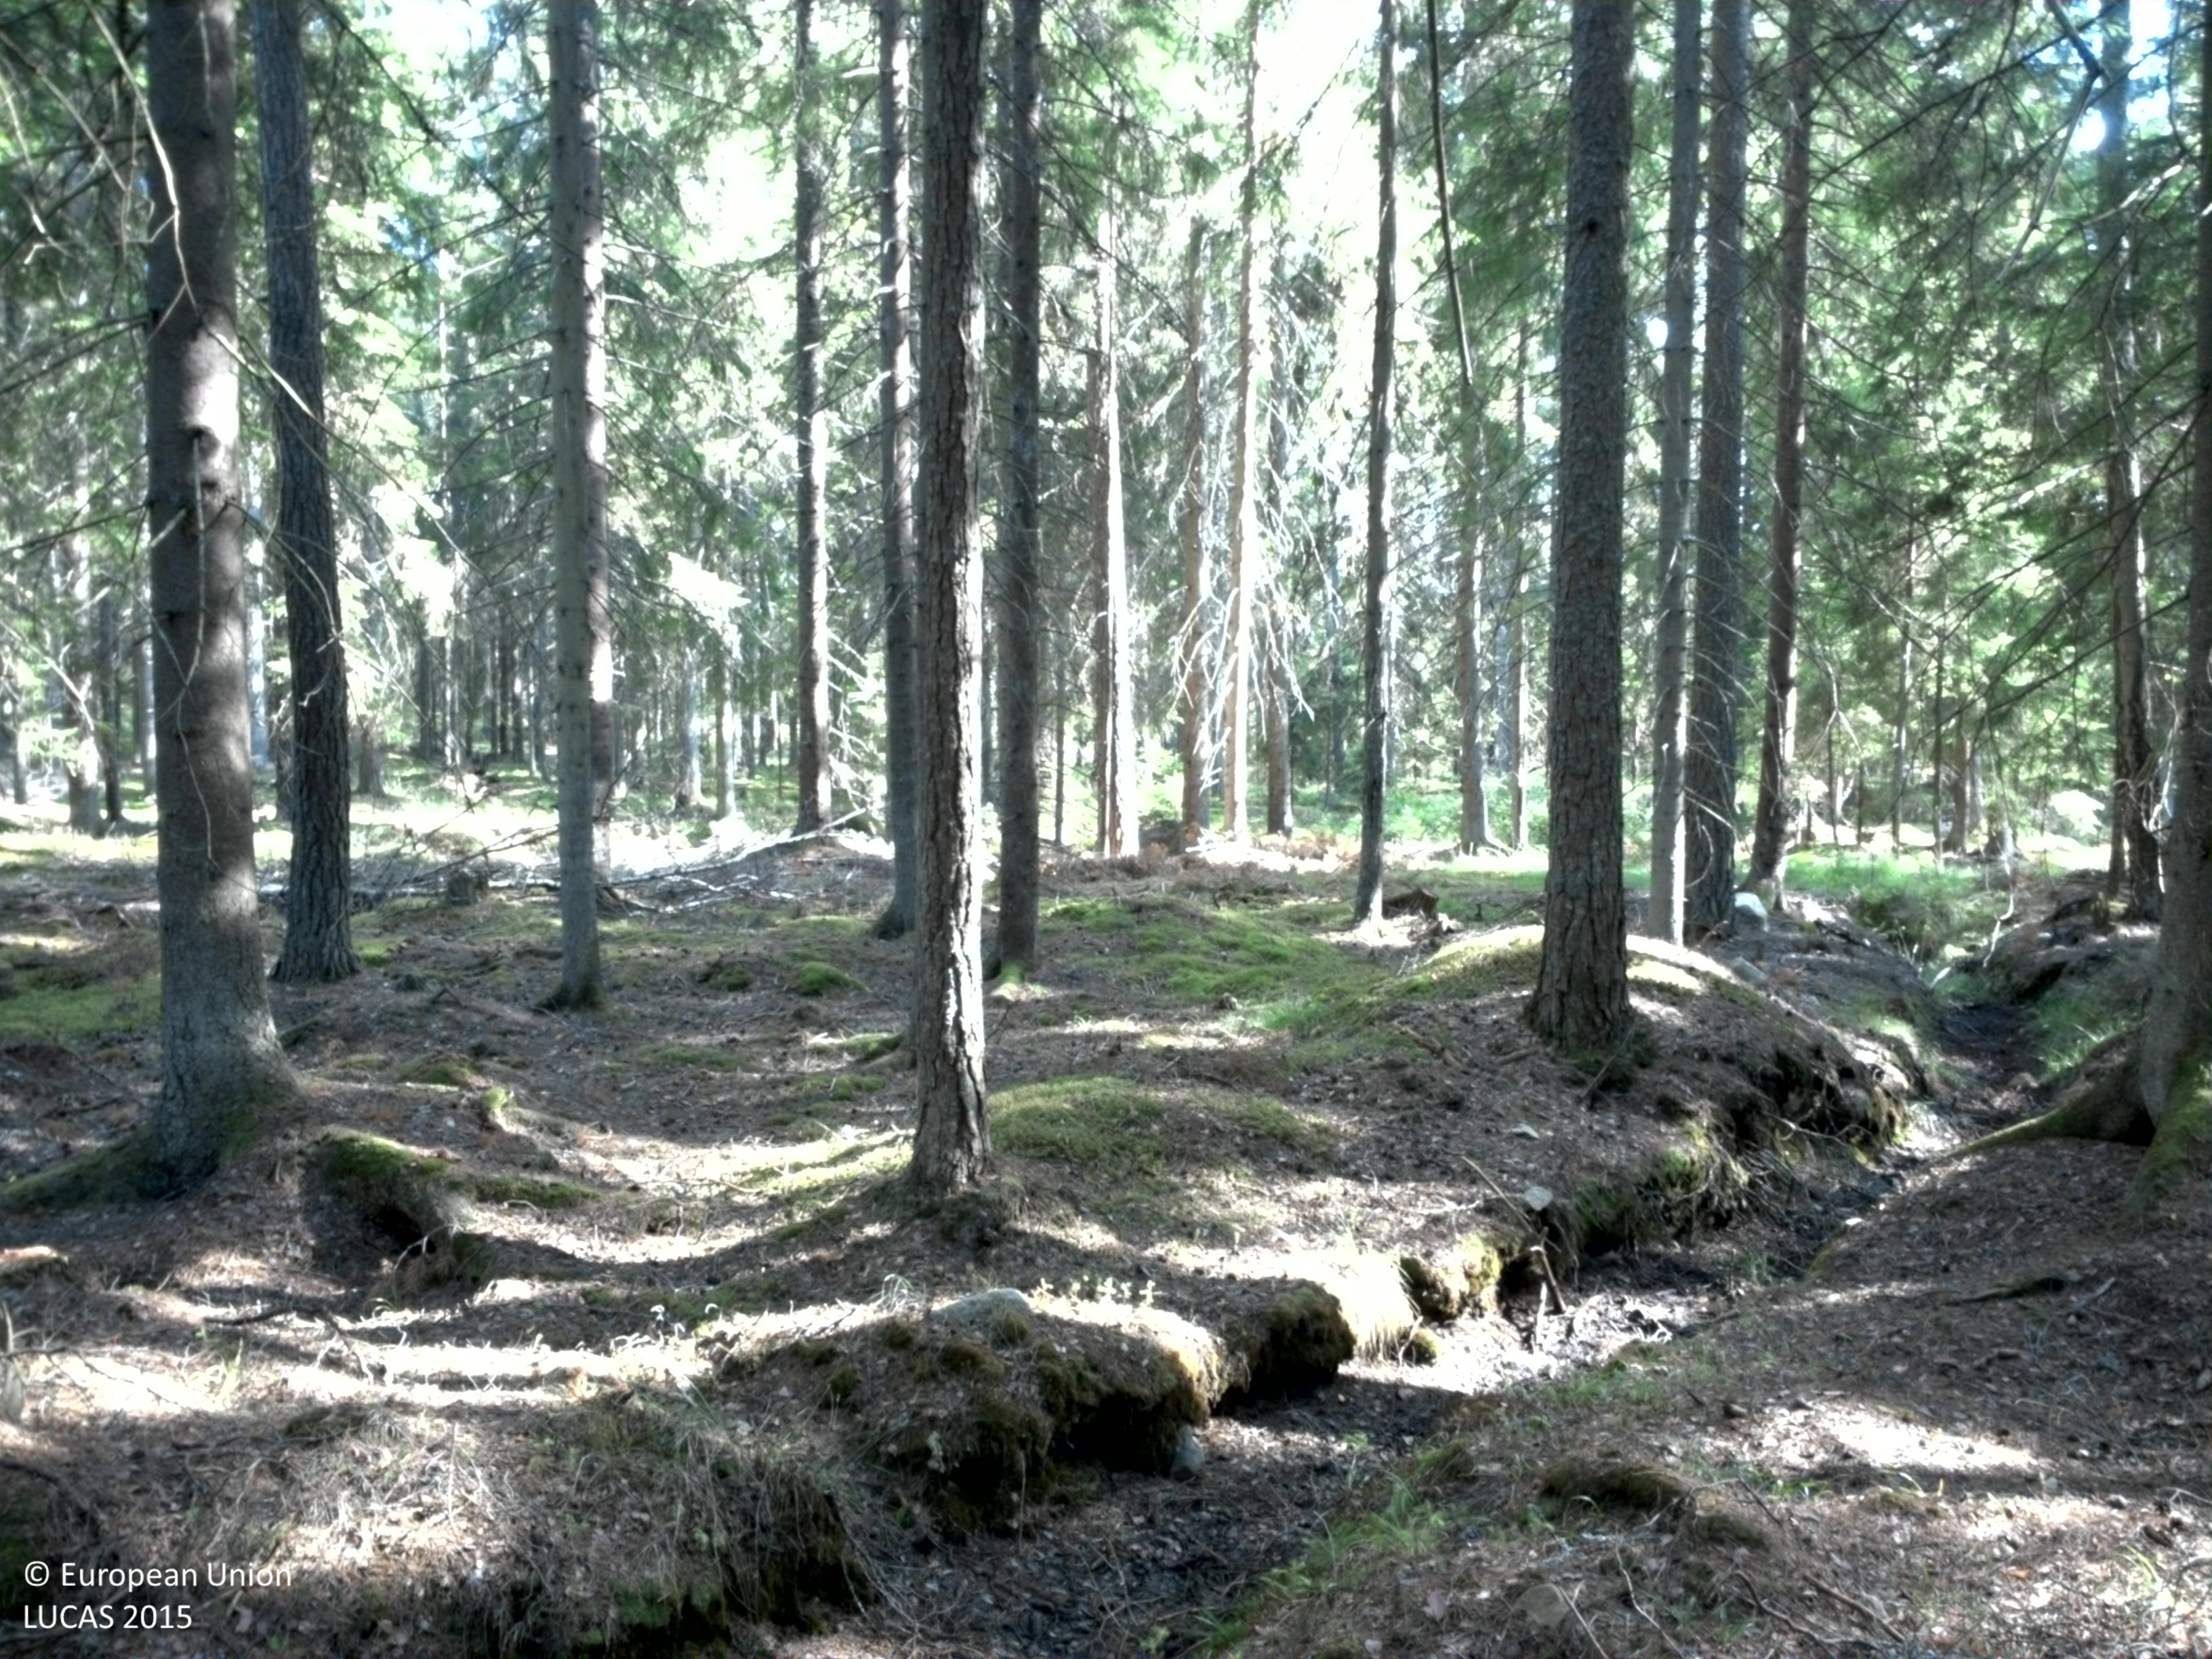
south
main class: Woodland
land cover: Spruce dominated coniferous woodland
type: boreal forest
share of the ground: 50 - 75 %
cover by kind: coniferous forest trees 75 %, lichens and mosses 20 %, unconsolidated bare surface 5 %
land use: Forestry
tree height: > 5 m
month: July
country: SE
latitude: 58.6461
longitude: 14.0080
